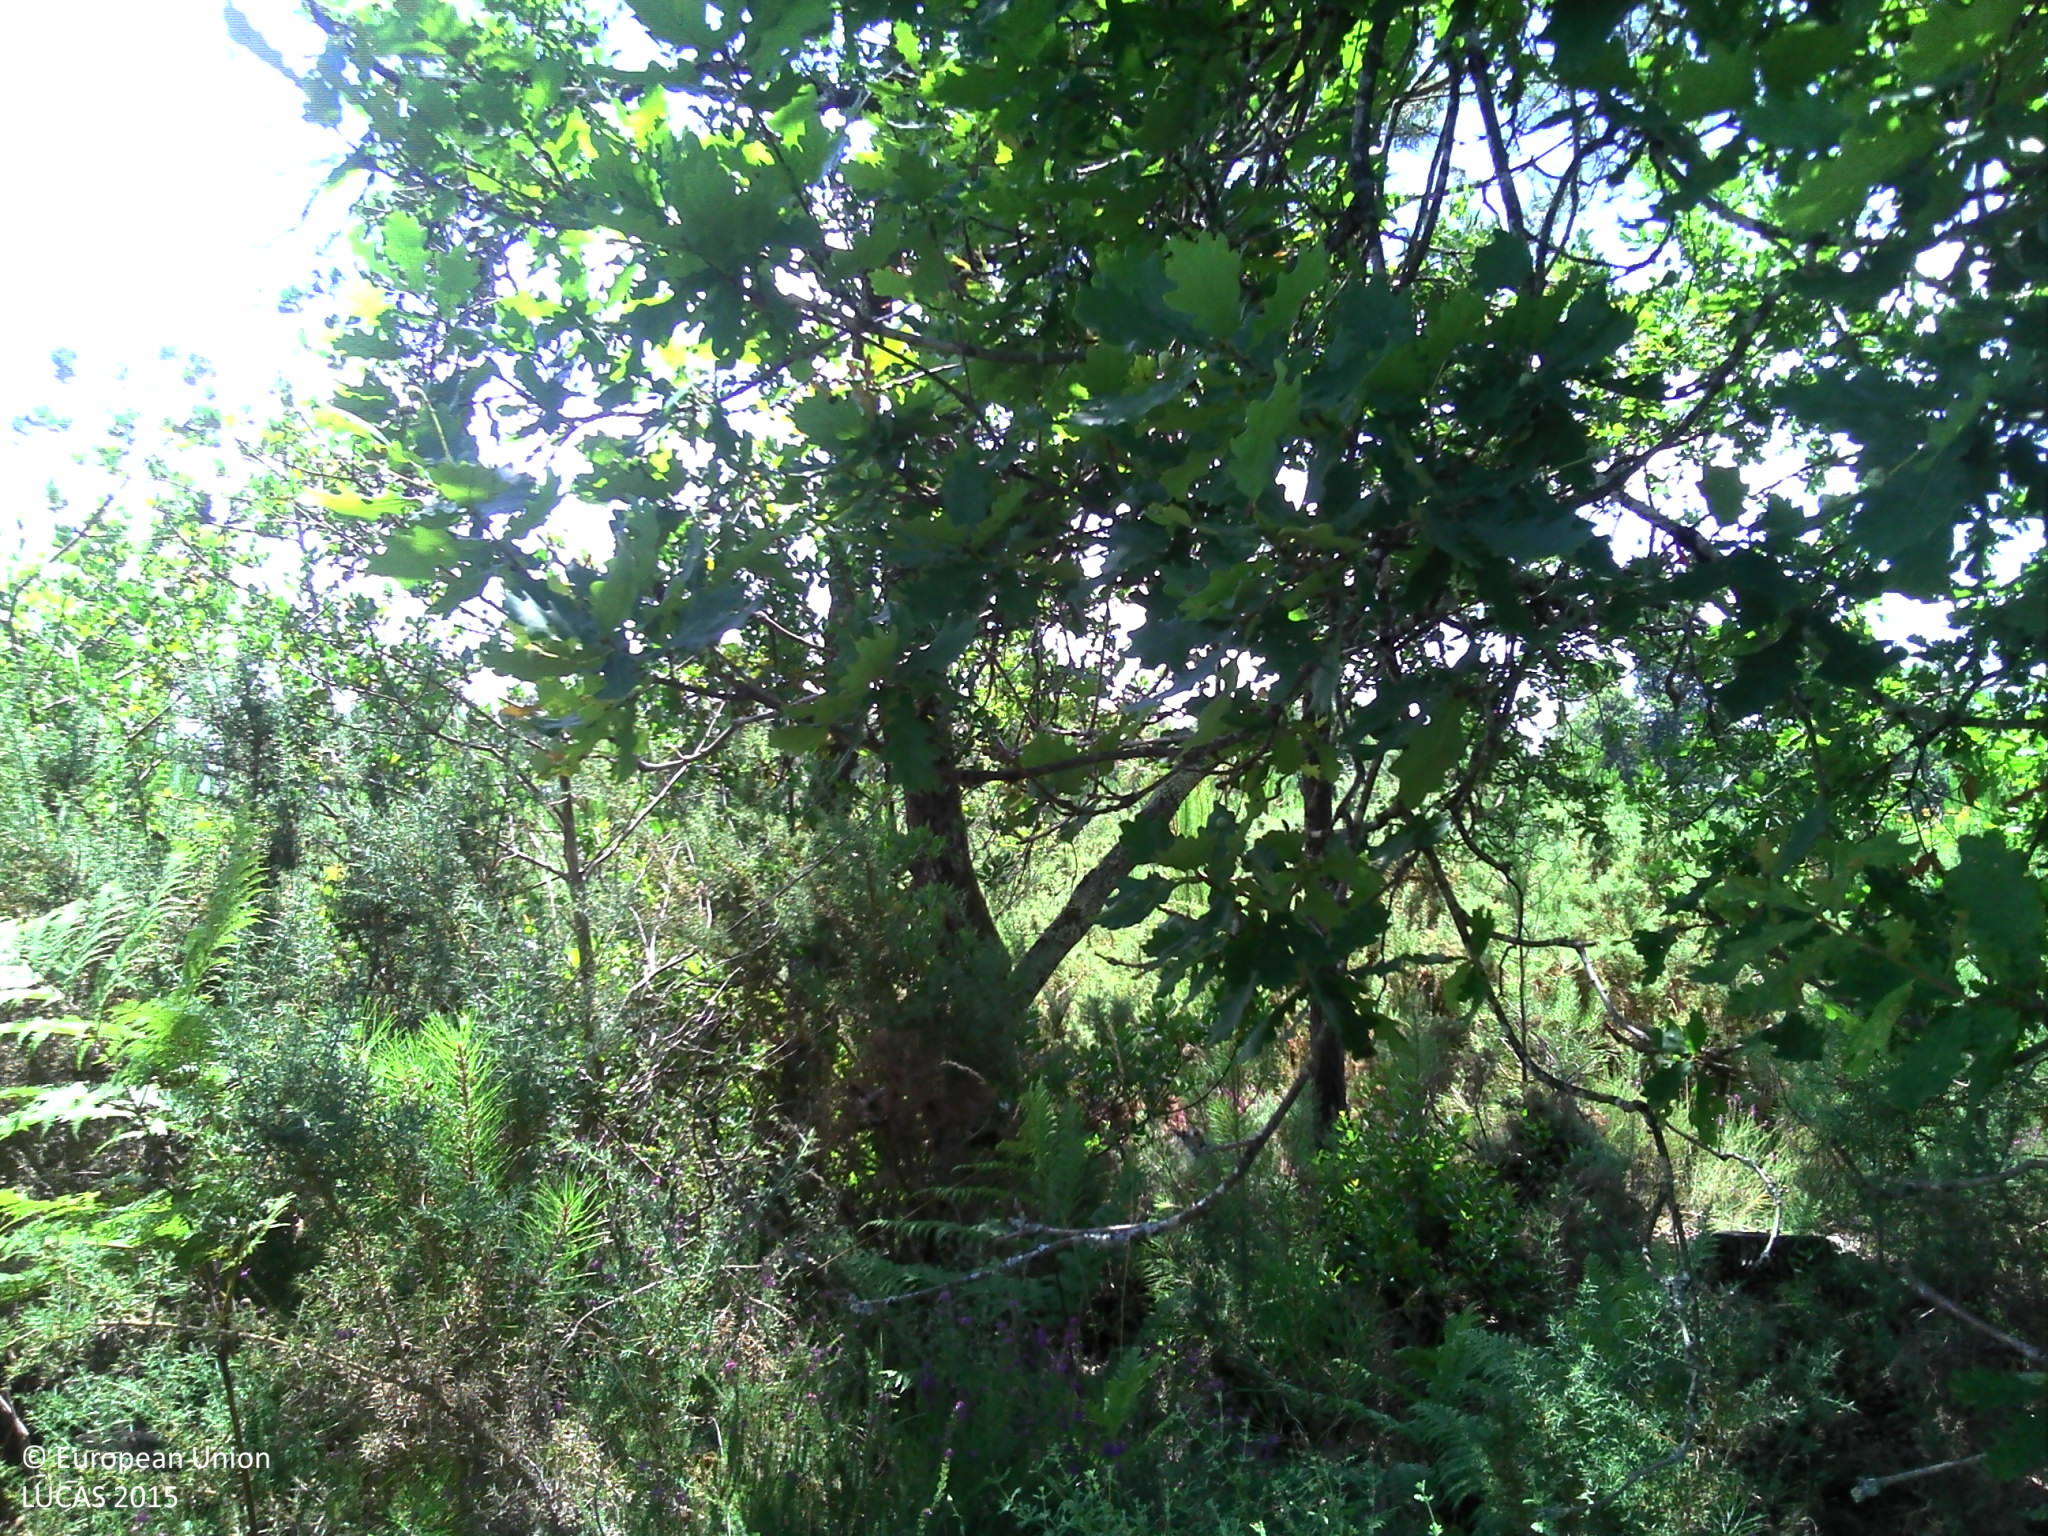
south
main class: Woodland
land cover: Pine dominated mixed woodland
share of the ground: > 75 %
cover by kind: coniferous forest trees 40 %, broadleaved forest trees 40 %, shrubs 10 %, herbaceous plants 10 %
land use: Forestry
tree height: > 5 m
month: July
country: FR
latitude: 43.9787
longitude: -1.2014
